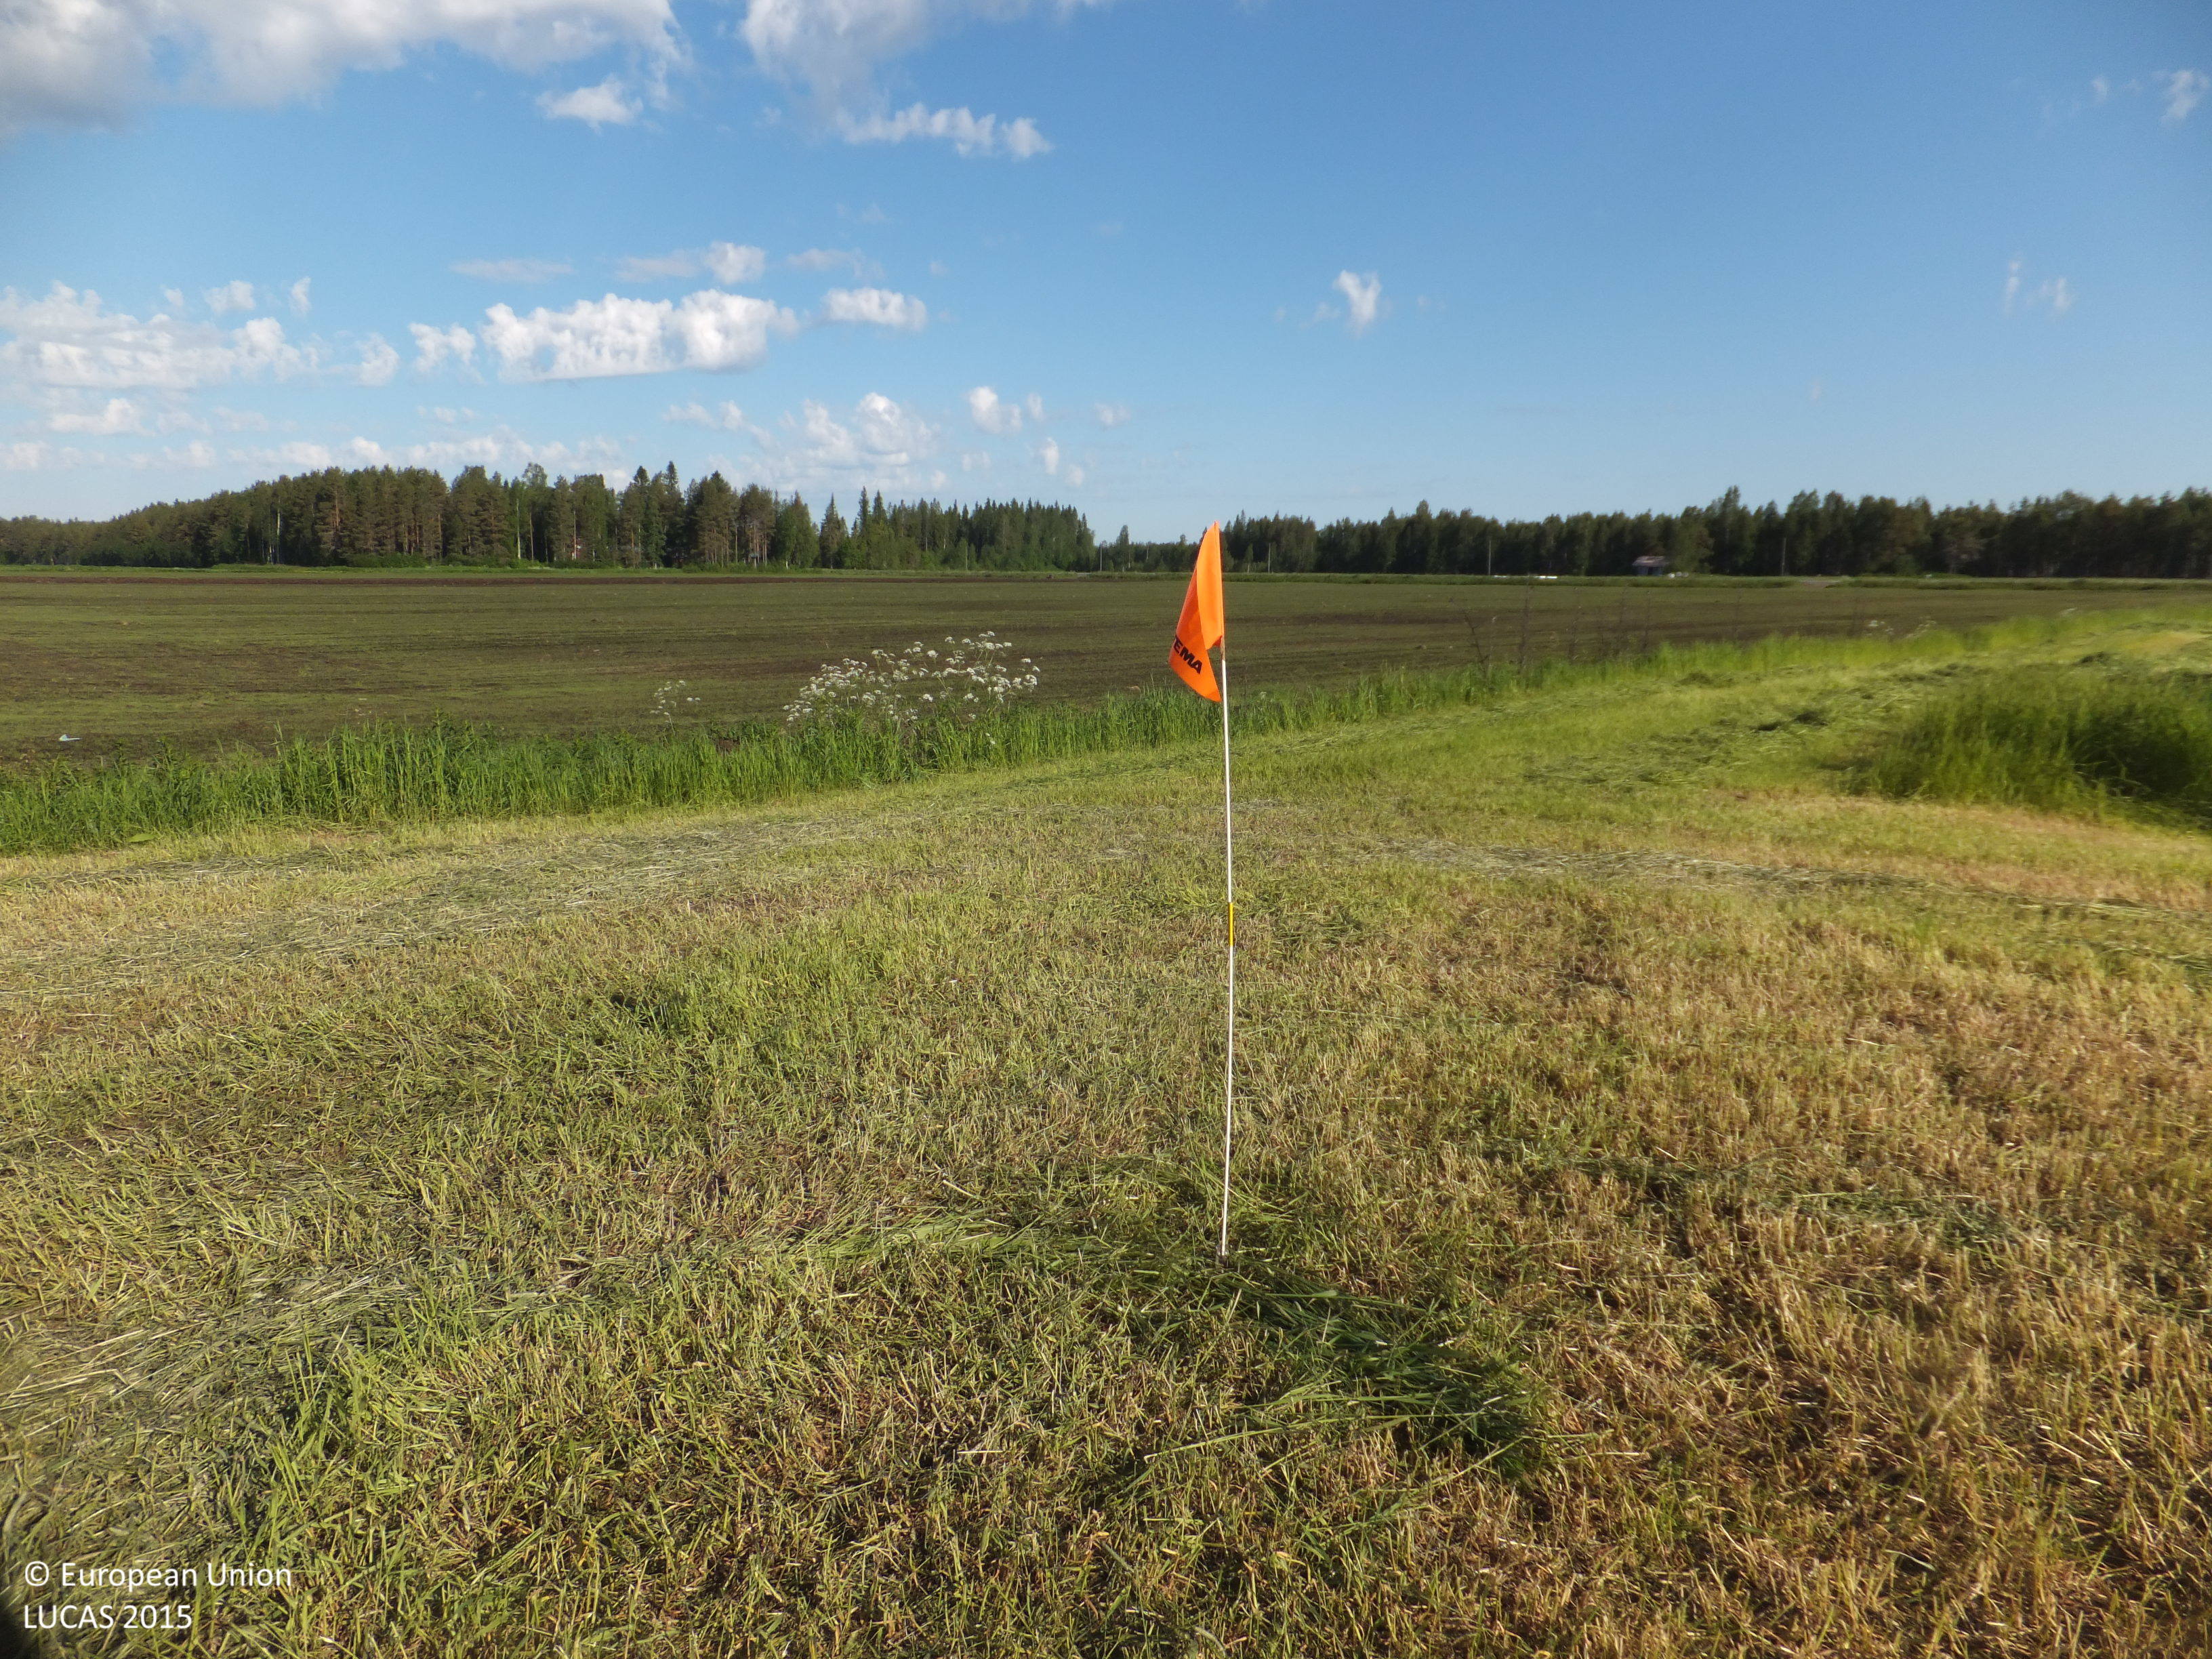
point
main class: Cropland
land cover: Temporary grasslands
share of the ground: 50 - 75 %
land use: Agriculture (excluding fallow land and kitchen gardens)
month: June
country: FI
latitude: 63.2408
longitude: 24.1912
